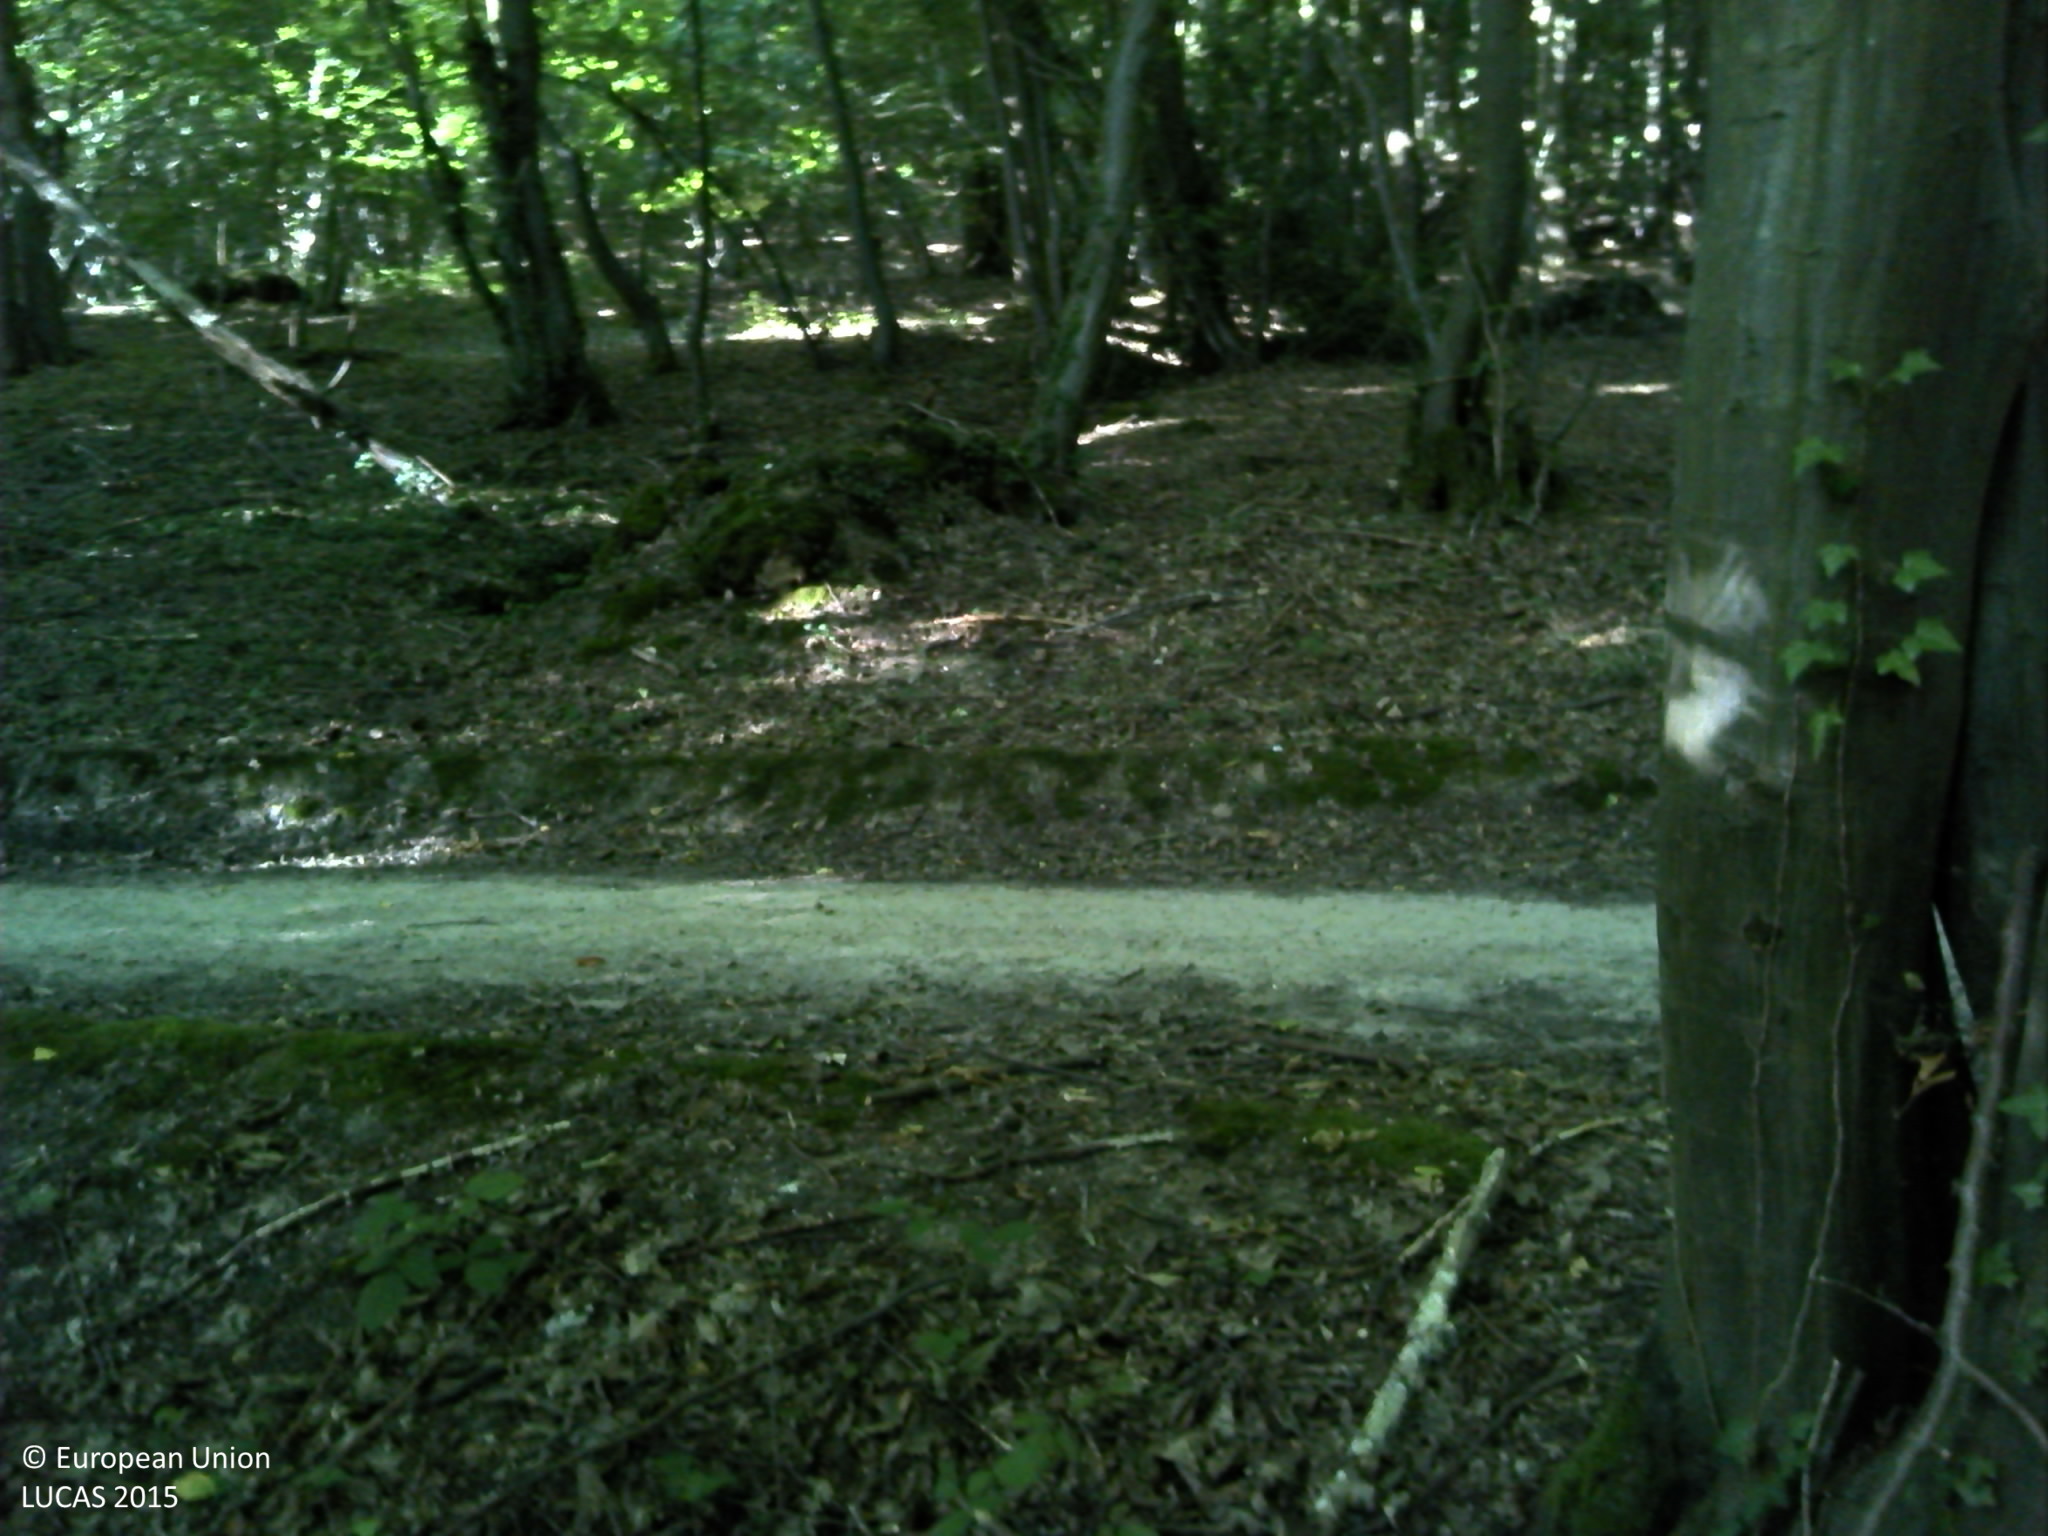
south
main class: Woodland
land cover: Broadleaved woodland
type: mesophytic deciduous forest
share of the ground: > 75 %
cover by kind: broadleaved forest trees 100 %
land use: Forestry
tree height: > 5 m
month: June
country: FR
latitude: 49.2692
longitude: 1.0314
